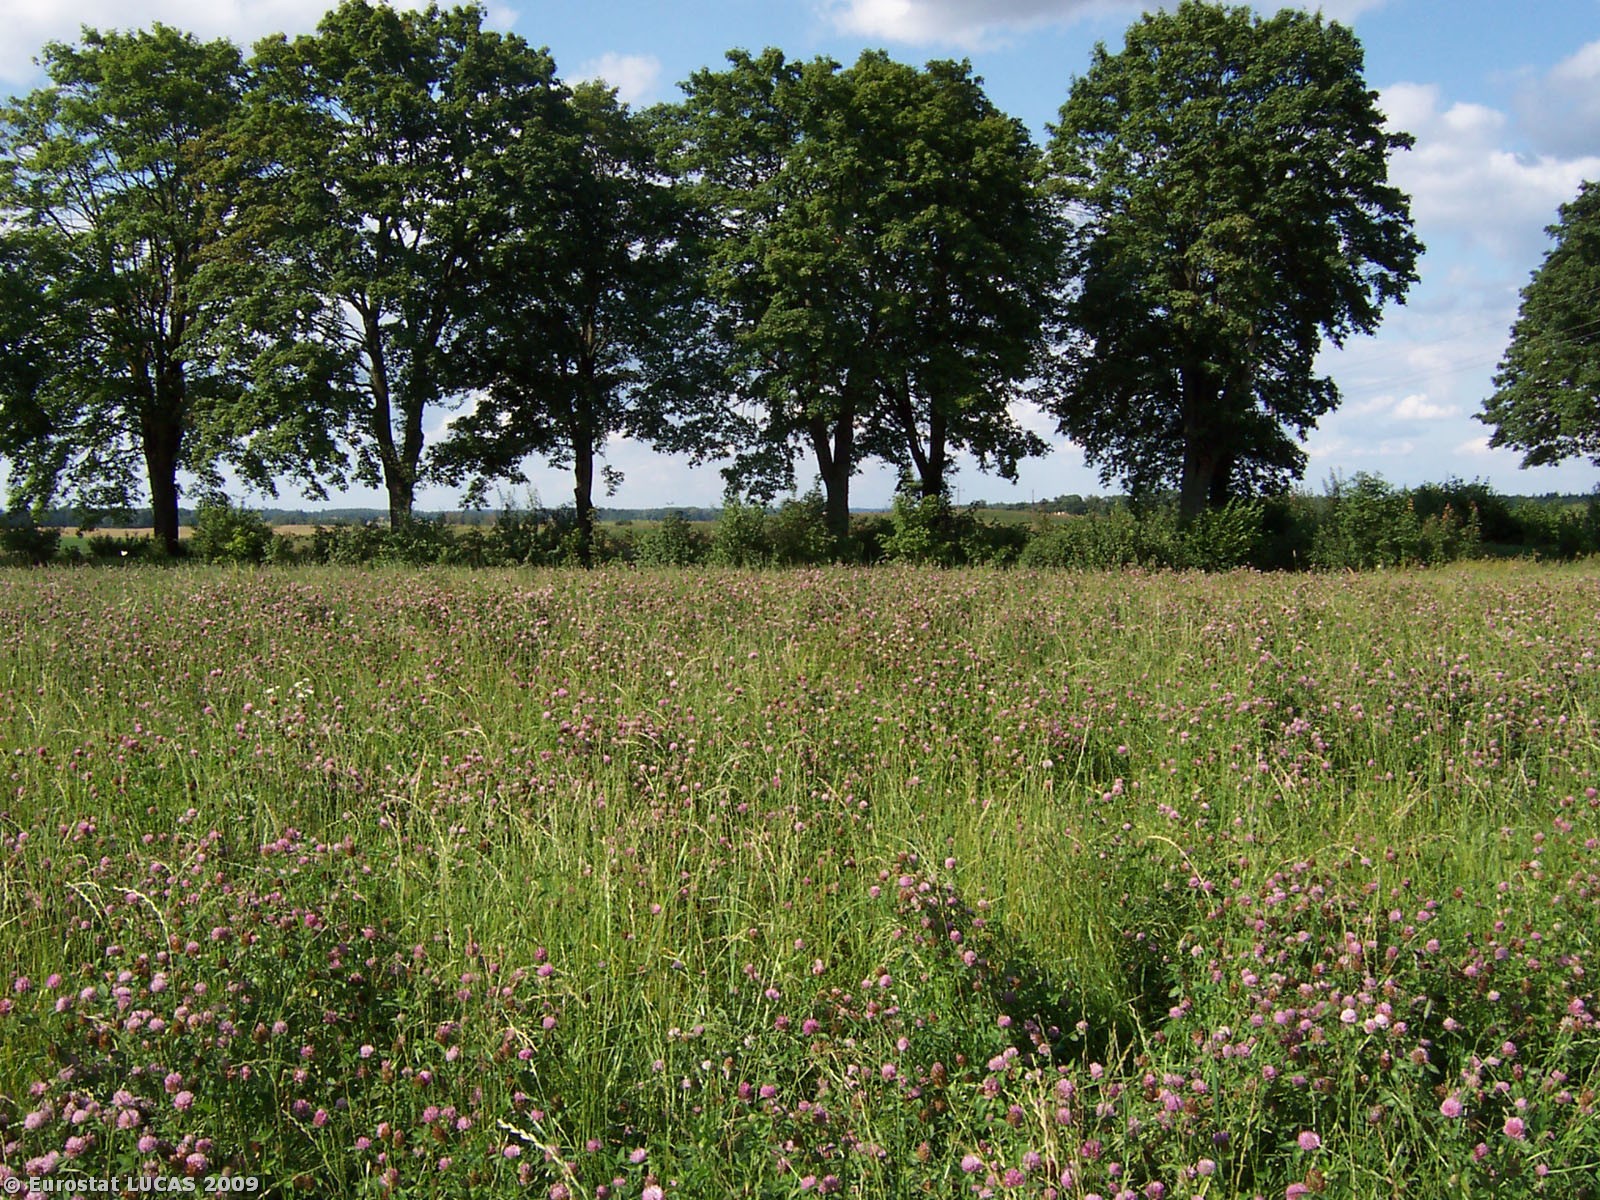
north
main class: Cropland
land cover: Clovers
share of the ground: > 75 %
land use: Agriculture (excluding fallow land and kitchen gardens)
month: August
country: PL
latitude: 53.7257
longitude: 21.0931
